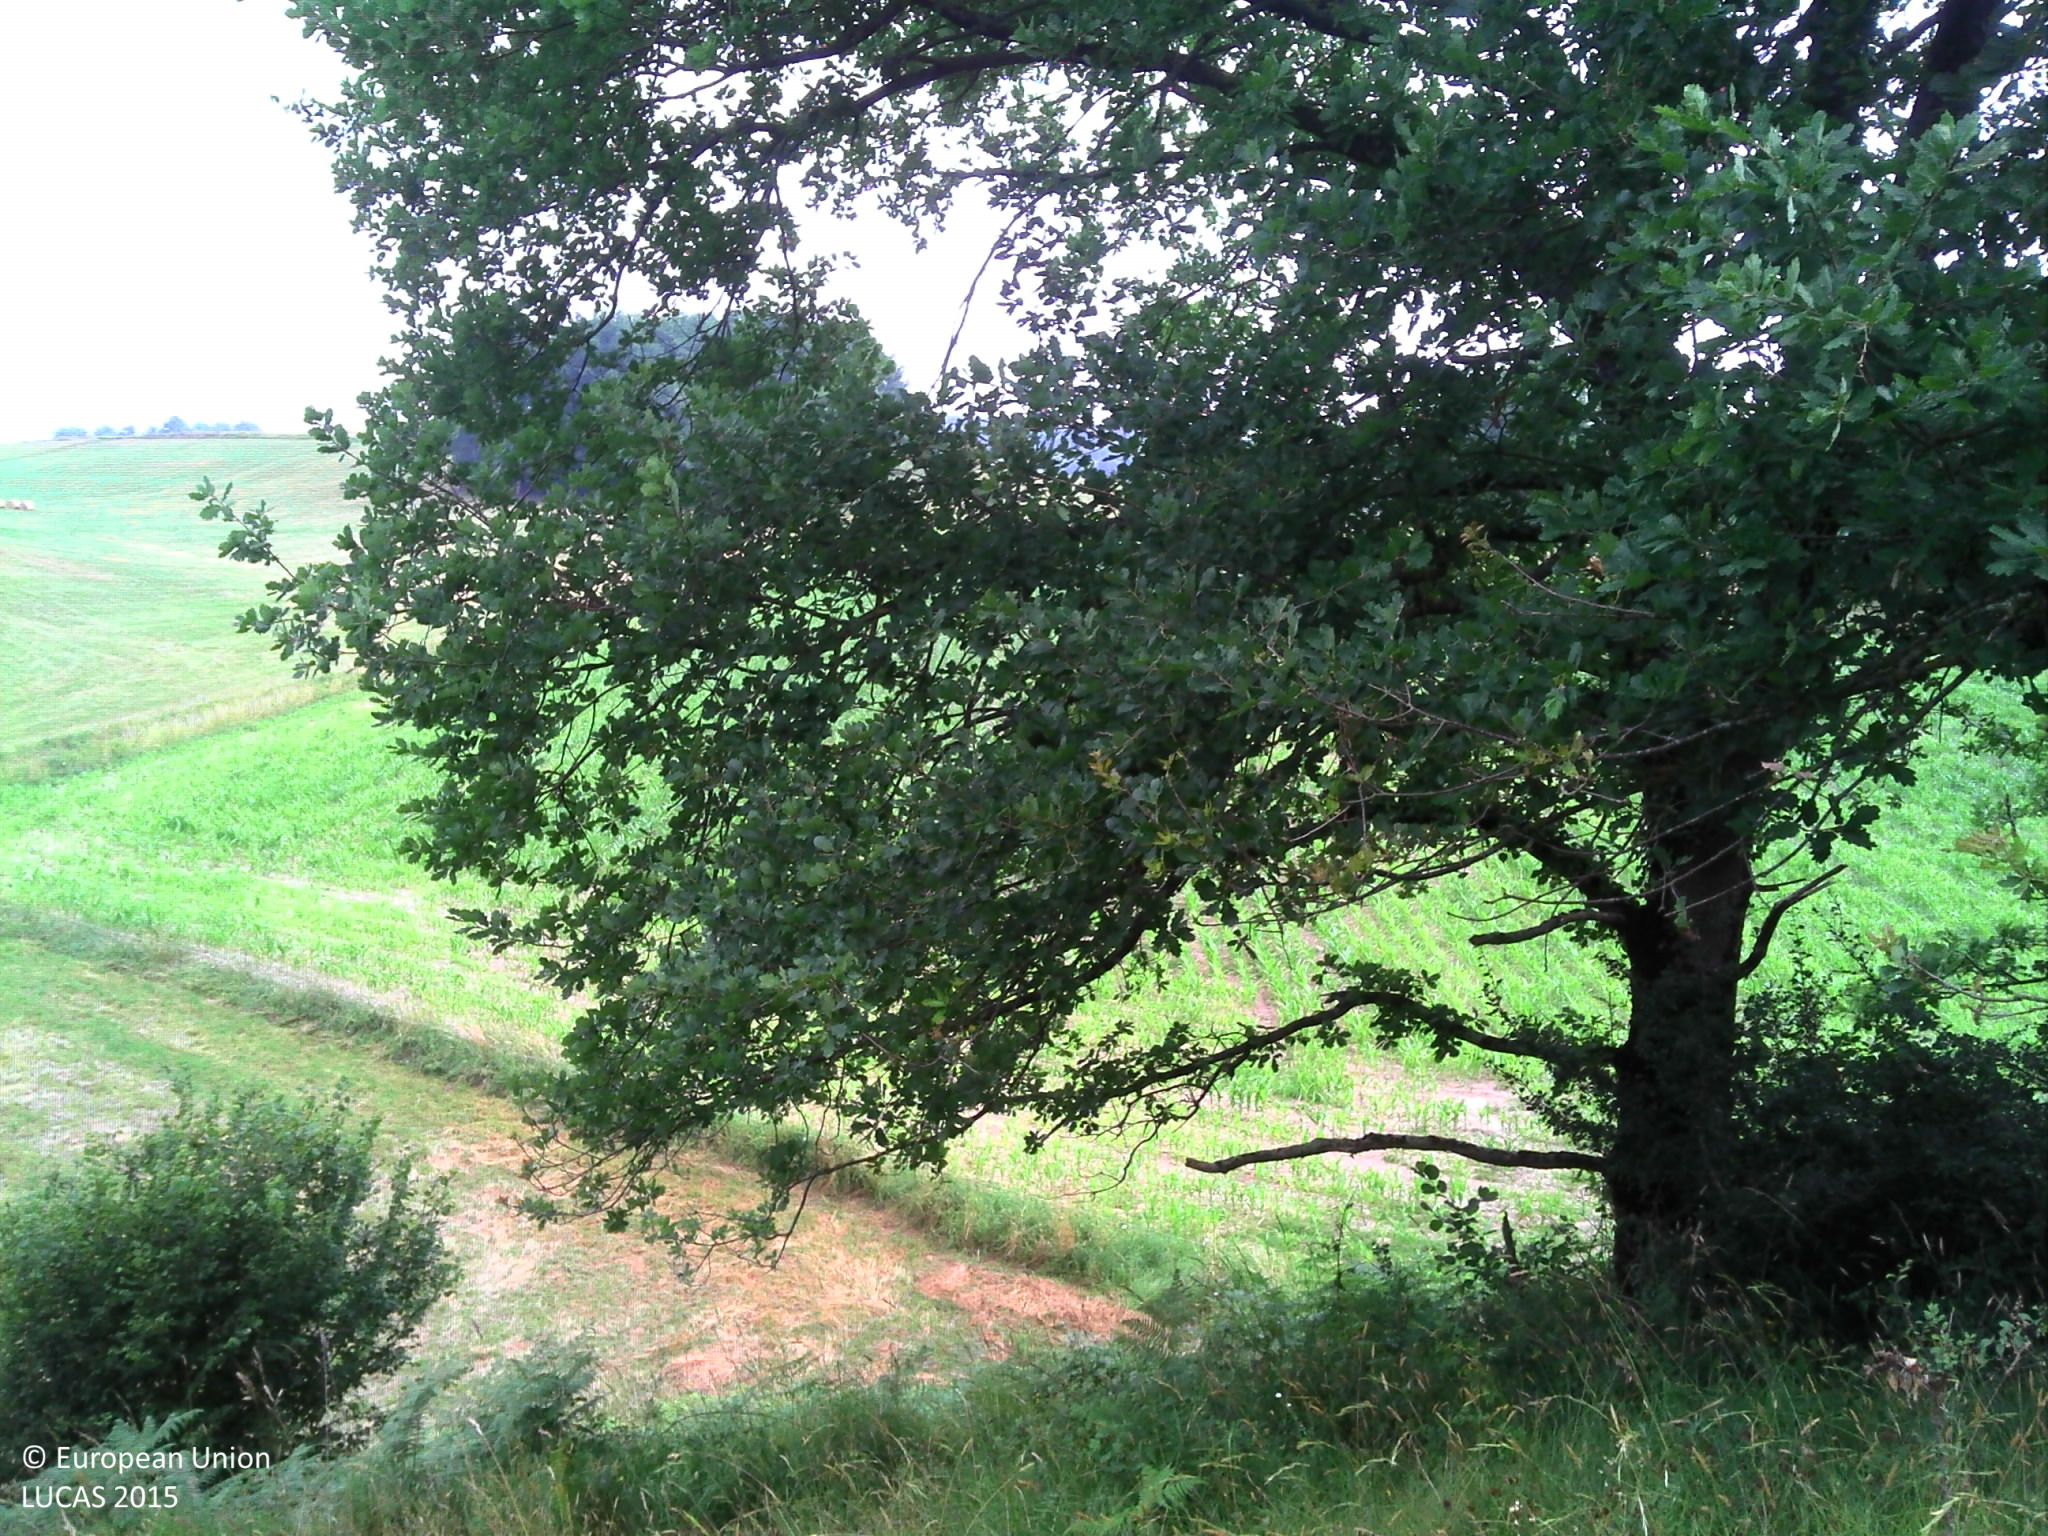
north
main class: Grassland
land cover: Grassland without tree/shrub cover
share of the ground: > 75 %
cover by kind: herbaceous plants 100 %
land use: Agriculture (excluding fallow land and kitchen gardens)
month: July
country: FR
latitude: 43.0222
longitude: 1.5022
